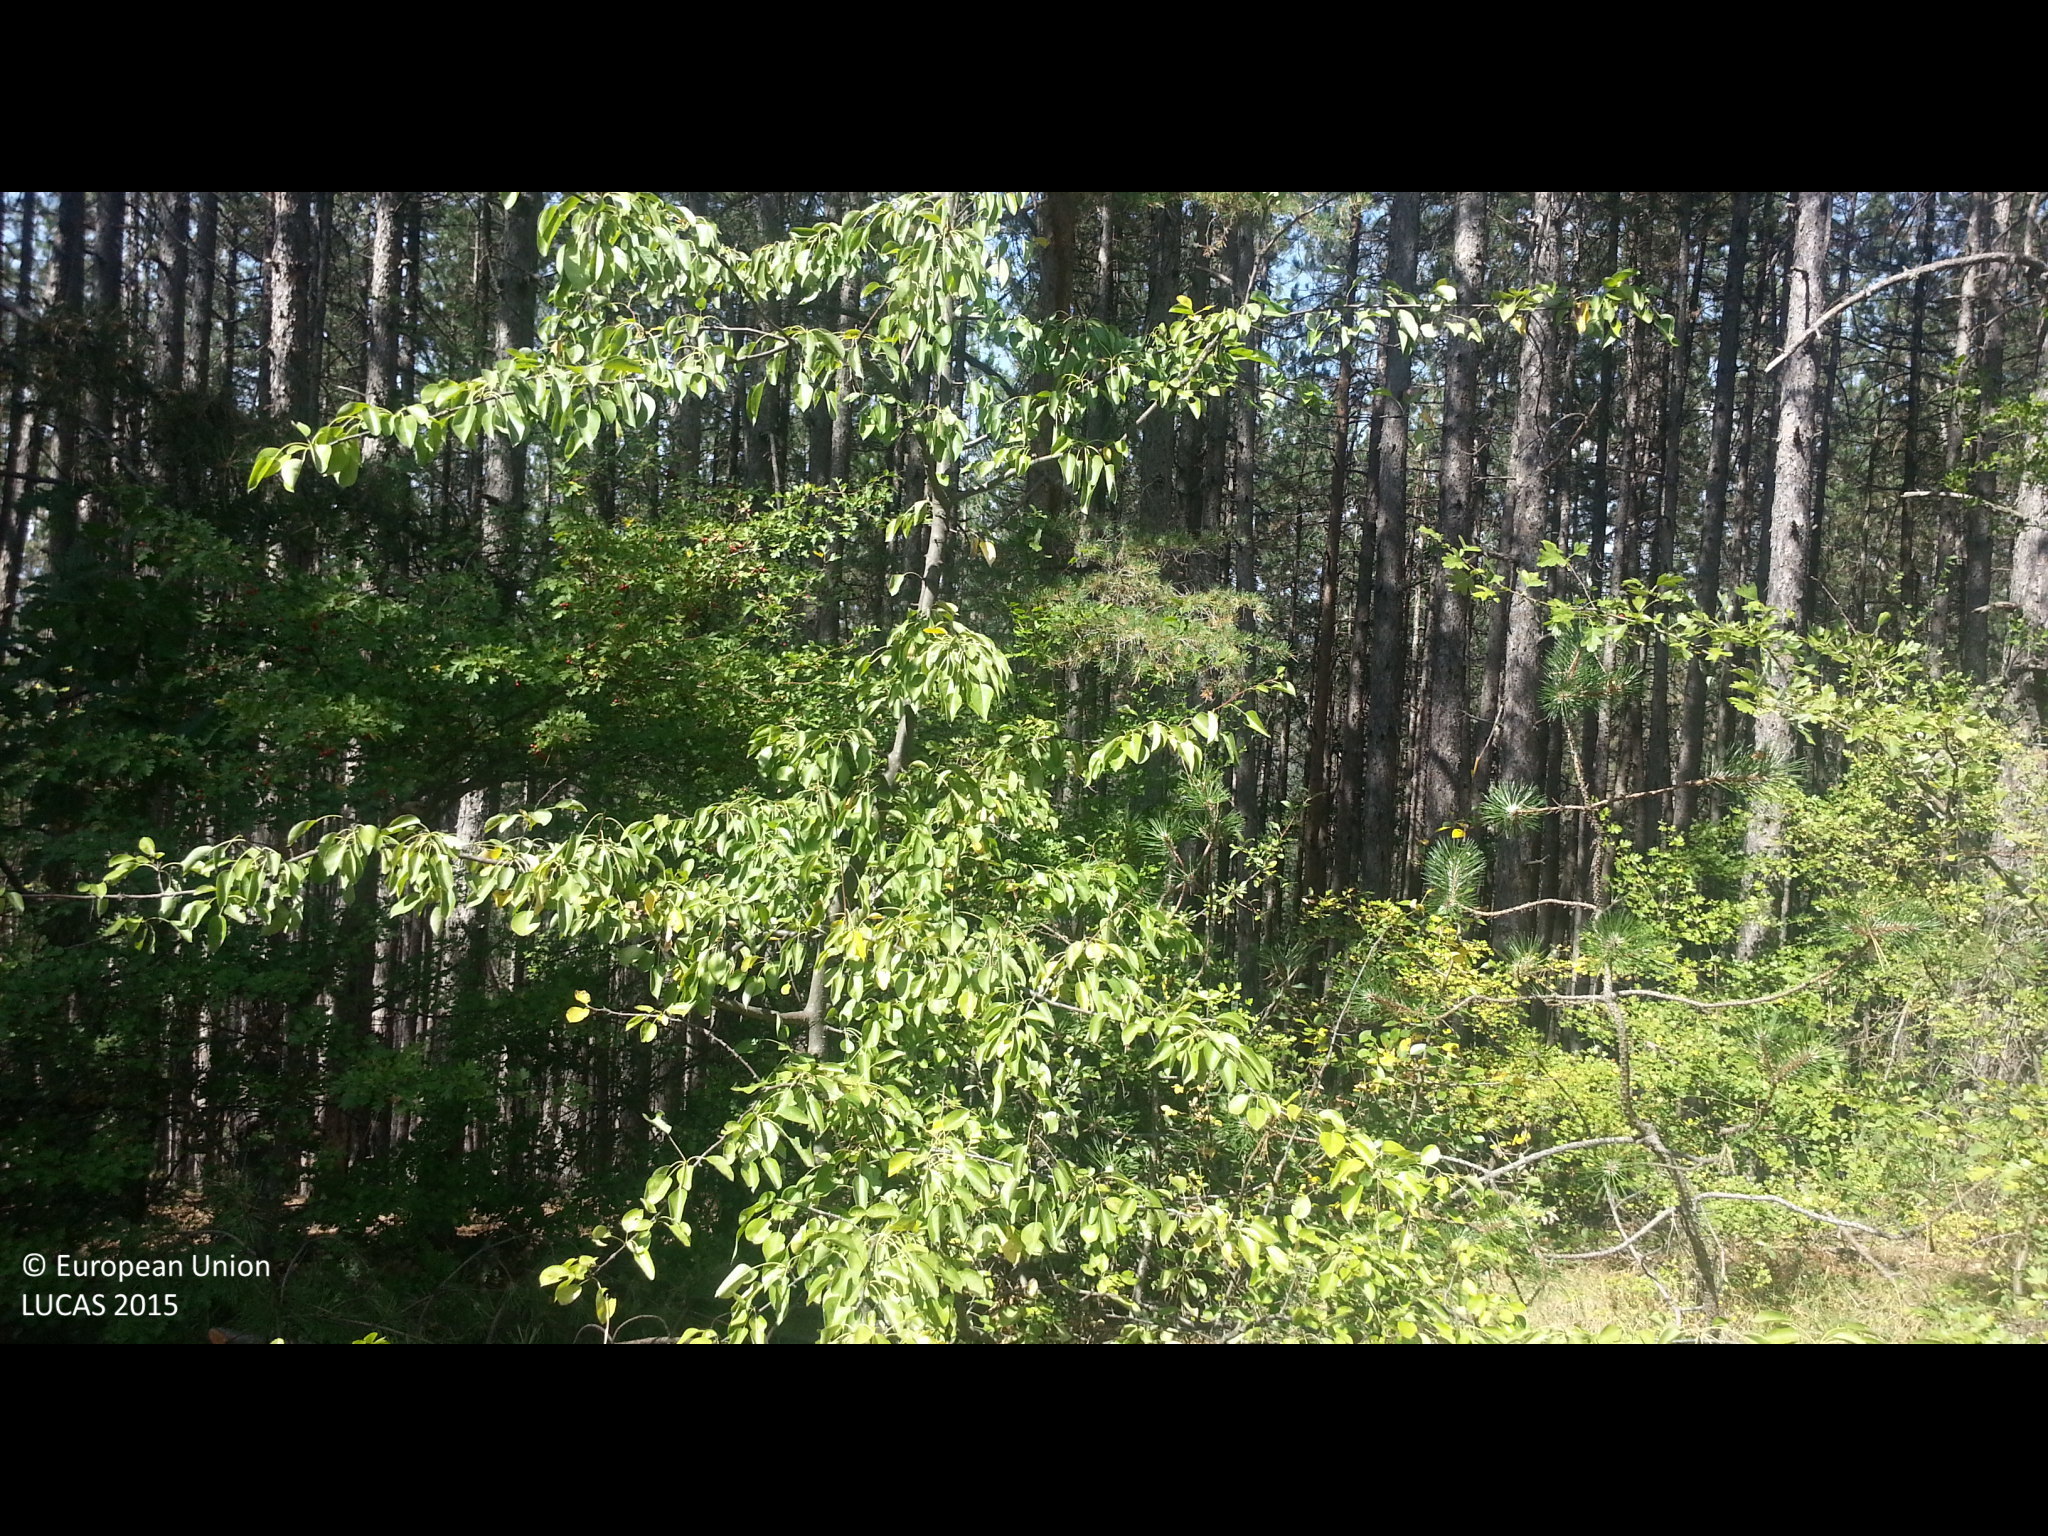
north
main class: Woodland
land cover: Pine dominated mixed woodland
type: hemiboreal forest and nemoral coniferous forest and mixed broadleaved-coniferous forest
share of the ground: > 75 %
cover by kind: coniferous forest trees 65 %, broadleaved forest trees 25 %, herbaceous plants 10 %
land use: Forestry
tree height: < 5 m
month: September
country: BG
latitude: 42.4294
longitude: 22.6023
